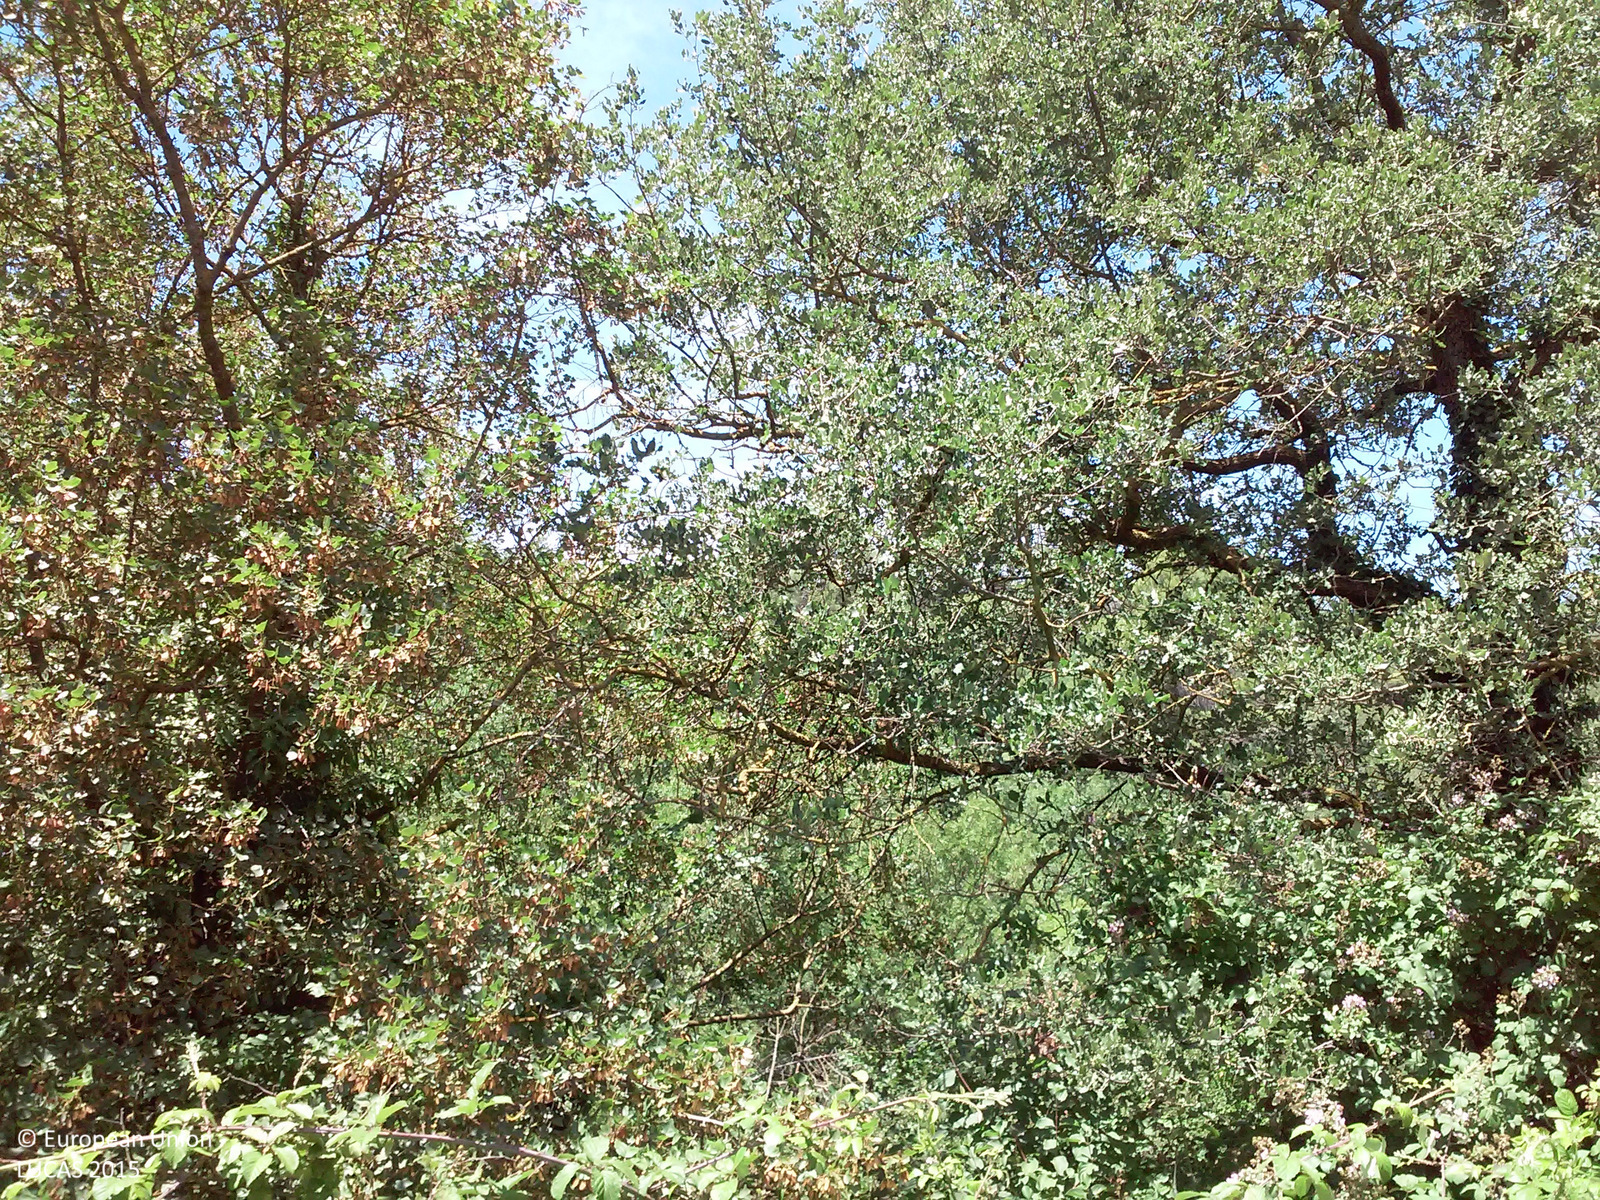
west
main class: Woodland
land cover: Broadleaved woodland
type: broadleaved evergreen forest
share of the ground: 50 - 75 %
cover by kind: herbaceous plants 40 %, broadleaved forest trees 25 %, shrubs 25 %, lichens and mosses 10 %
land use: Semi-natural and natural areas not in use
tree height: < 5 m
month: July
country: ES
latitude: 41.5284
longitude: 1.2300
